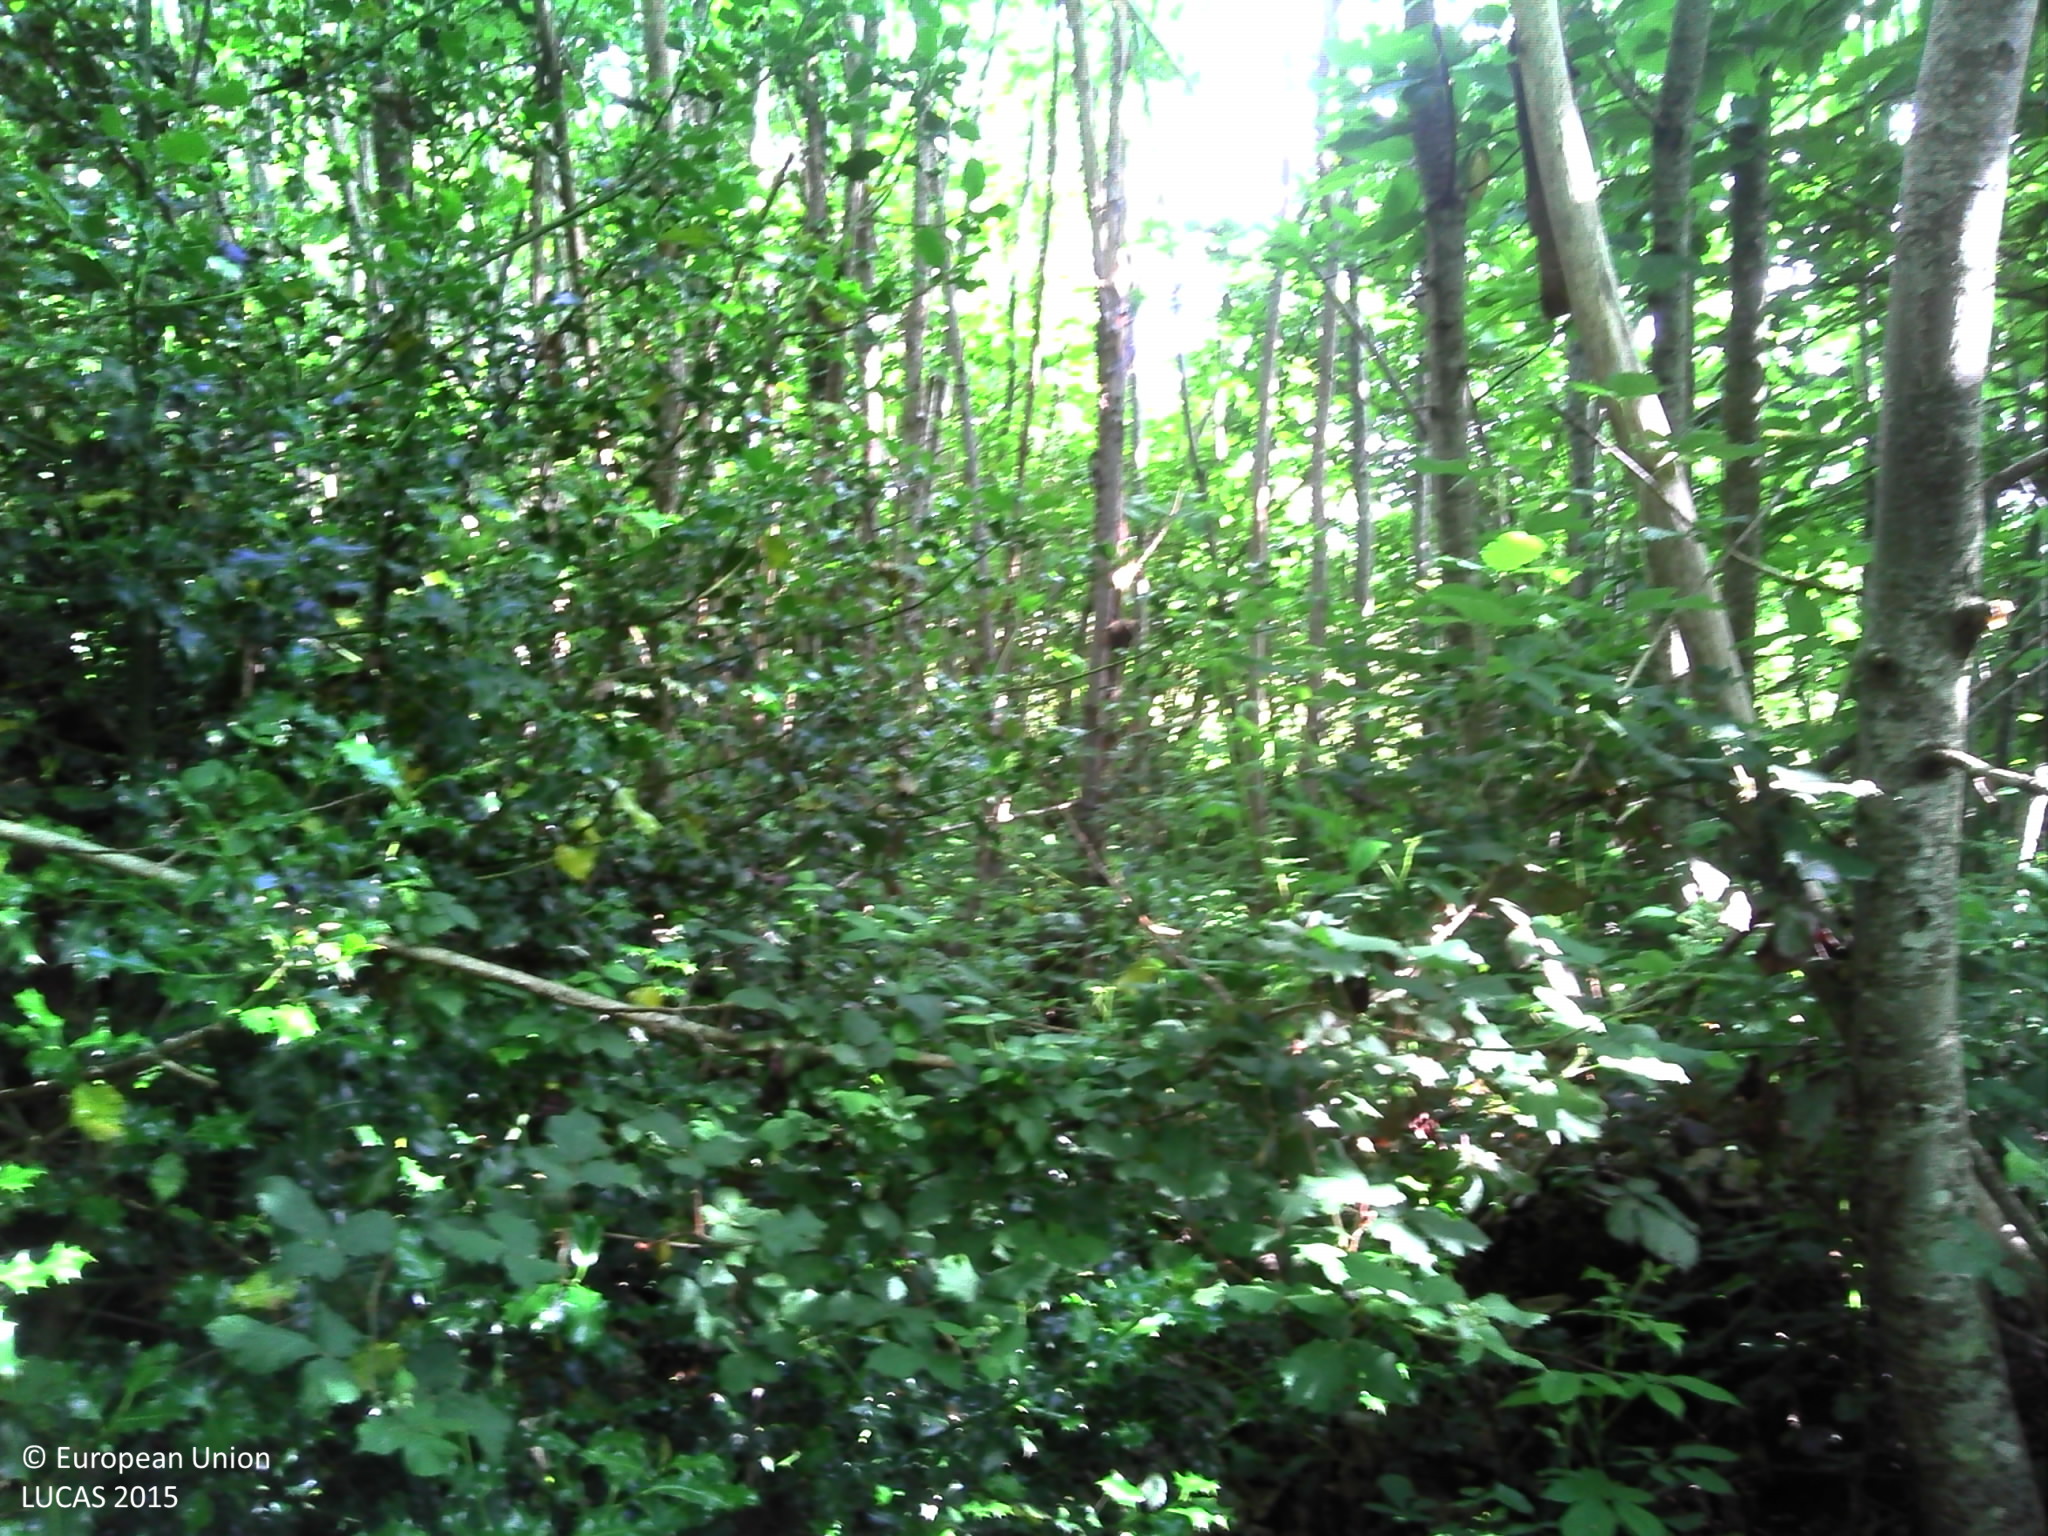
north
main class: Woodland
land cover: Broadleaved woodland
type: mesophytic deciduous forest
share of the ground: > 75 %
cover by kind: broadleaved forest trees 95 %, herbaceous plants 5 %
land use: Forestry
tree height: > 5 m
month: June
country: FR
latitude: 47.2072
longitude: -1.2736
